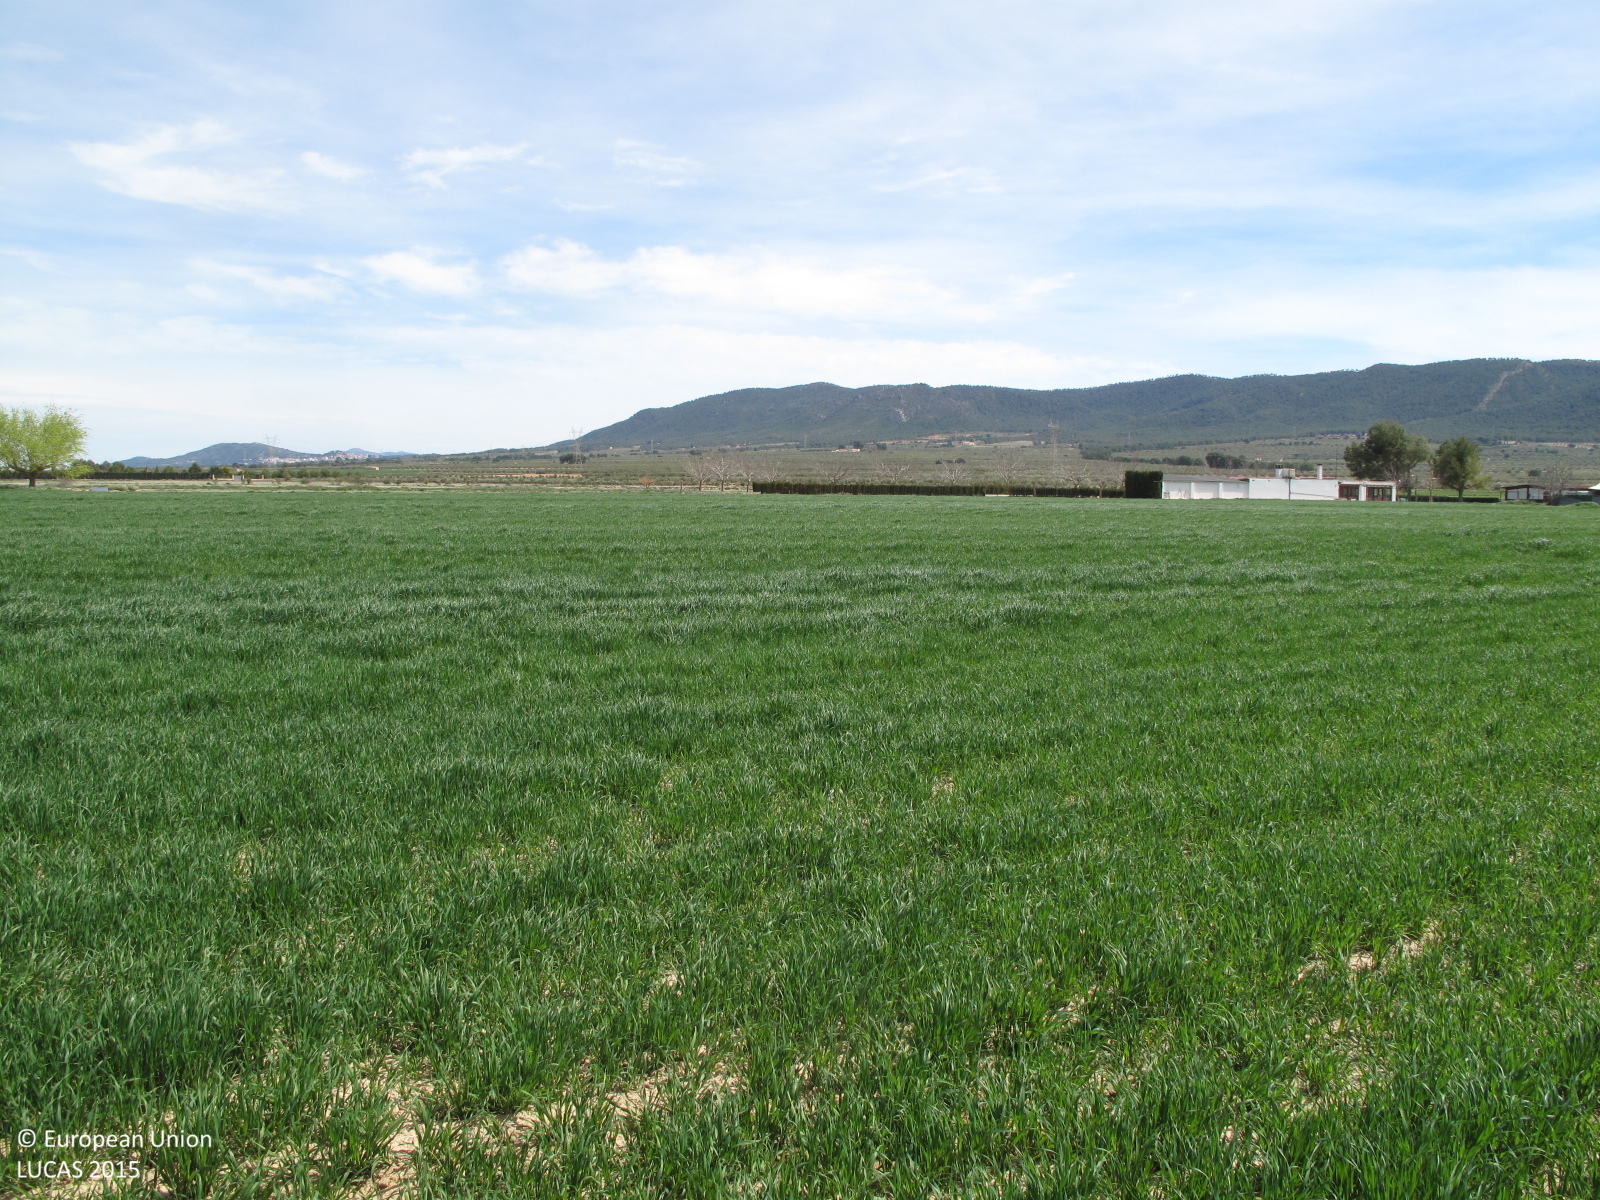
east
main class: Cropland
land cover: Barley
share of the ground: > 75 %
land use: Agriculture (excluding fallow land and kitchen gardens)
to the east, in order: Barley; Grass margins; Other bare soil; Managed hedges; Tracks; Managed hedges; Lines of trees; Spontaneously vegetated surfaces
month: March
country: ES
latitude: 38.6880
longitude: -0.7625
